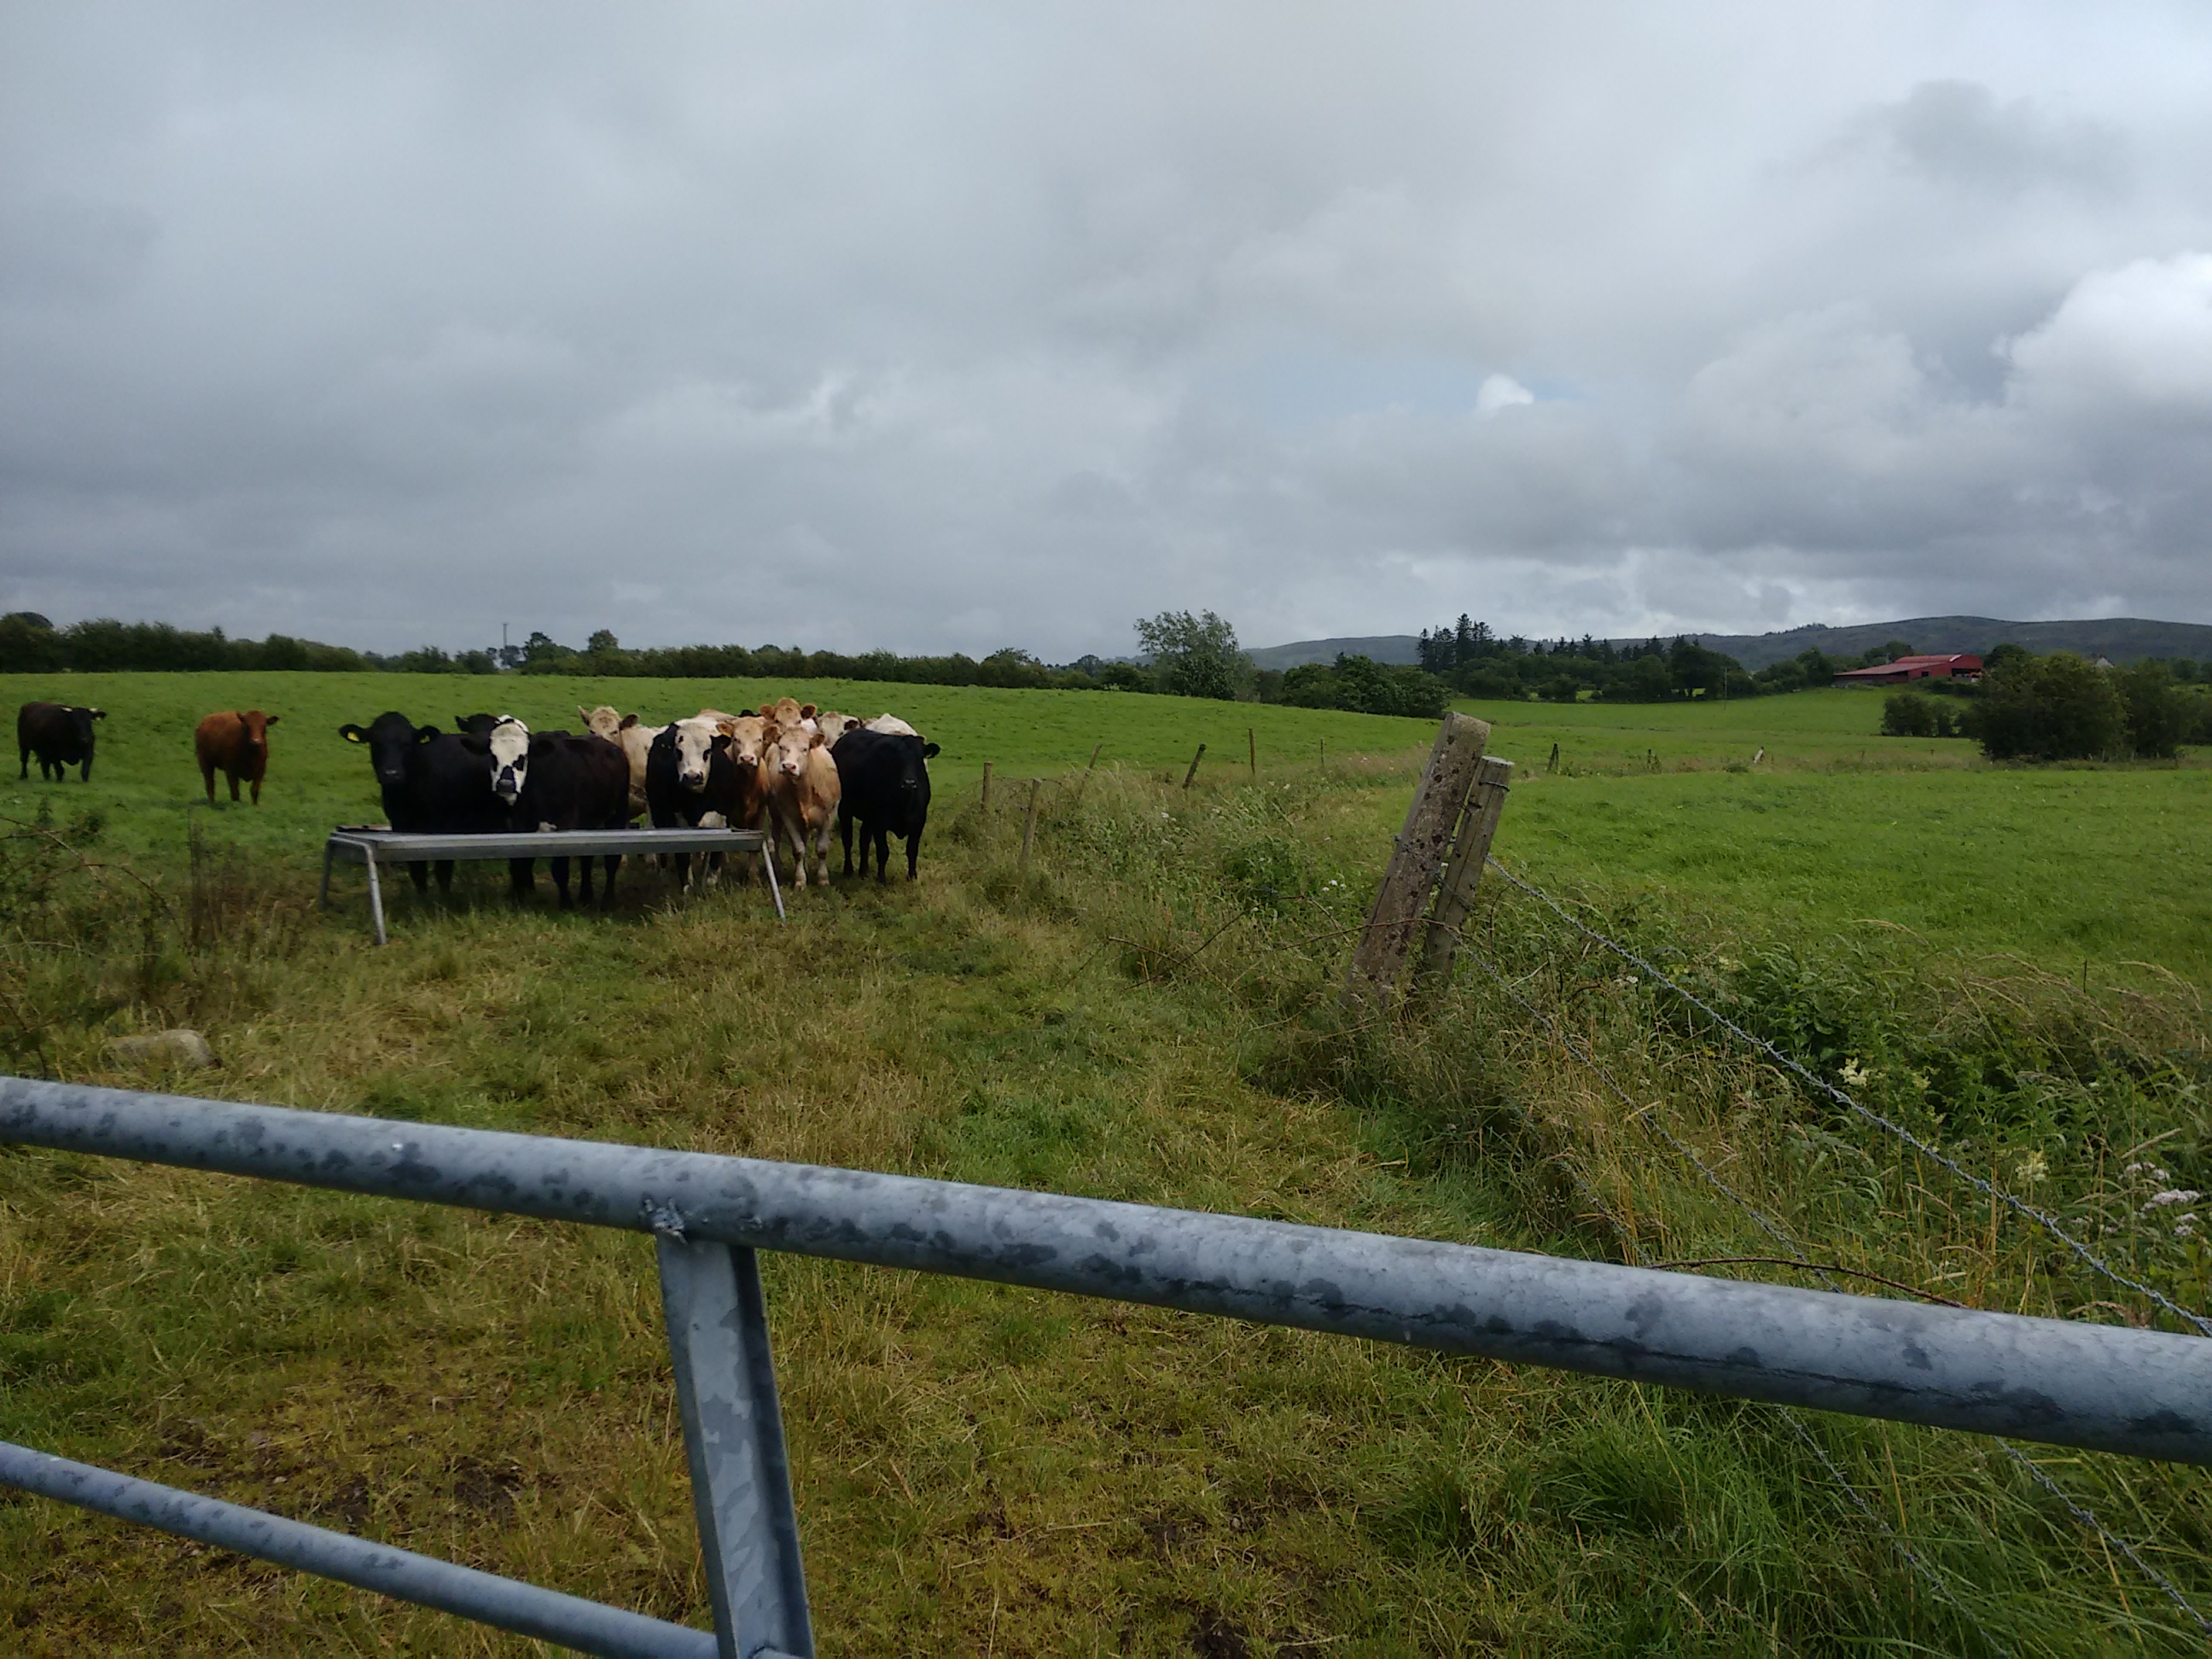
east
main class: Grassland
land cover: Grassland without tree/shrub cover
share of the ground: > 75 %
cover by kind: herbaceous plants 100 %
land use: Agriculture (excluding fallow land and kitchen gardens)
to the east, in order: Grassland without tree/shrub cover; Fences; Grass margins; Single bushes/trees; Grass margins; Rivers and streams; Grass margins; Fences; Grassland without tree/shrub cover; Fences; Single bushes/trees; Grass margins; Rivers and streams; Grassland without tree/shrub cover; Fences; Grassland without tree/shrub cover
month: July
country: GB
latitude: 54.3743
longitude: -7.2826
